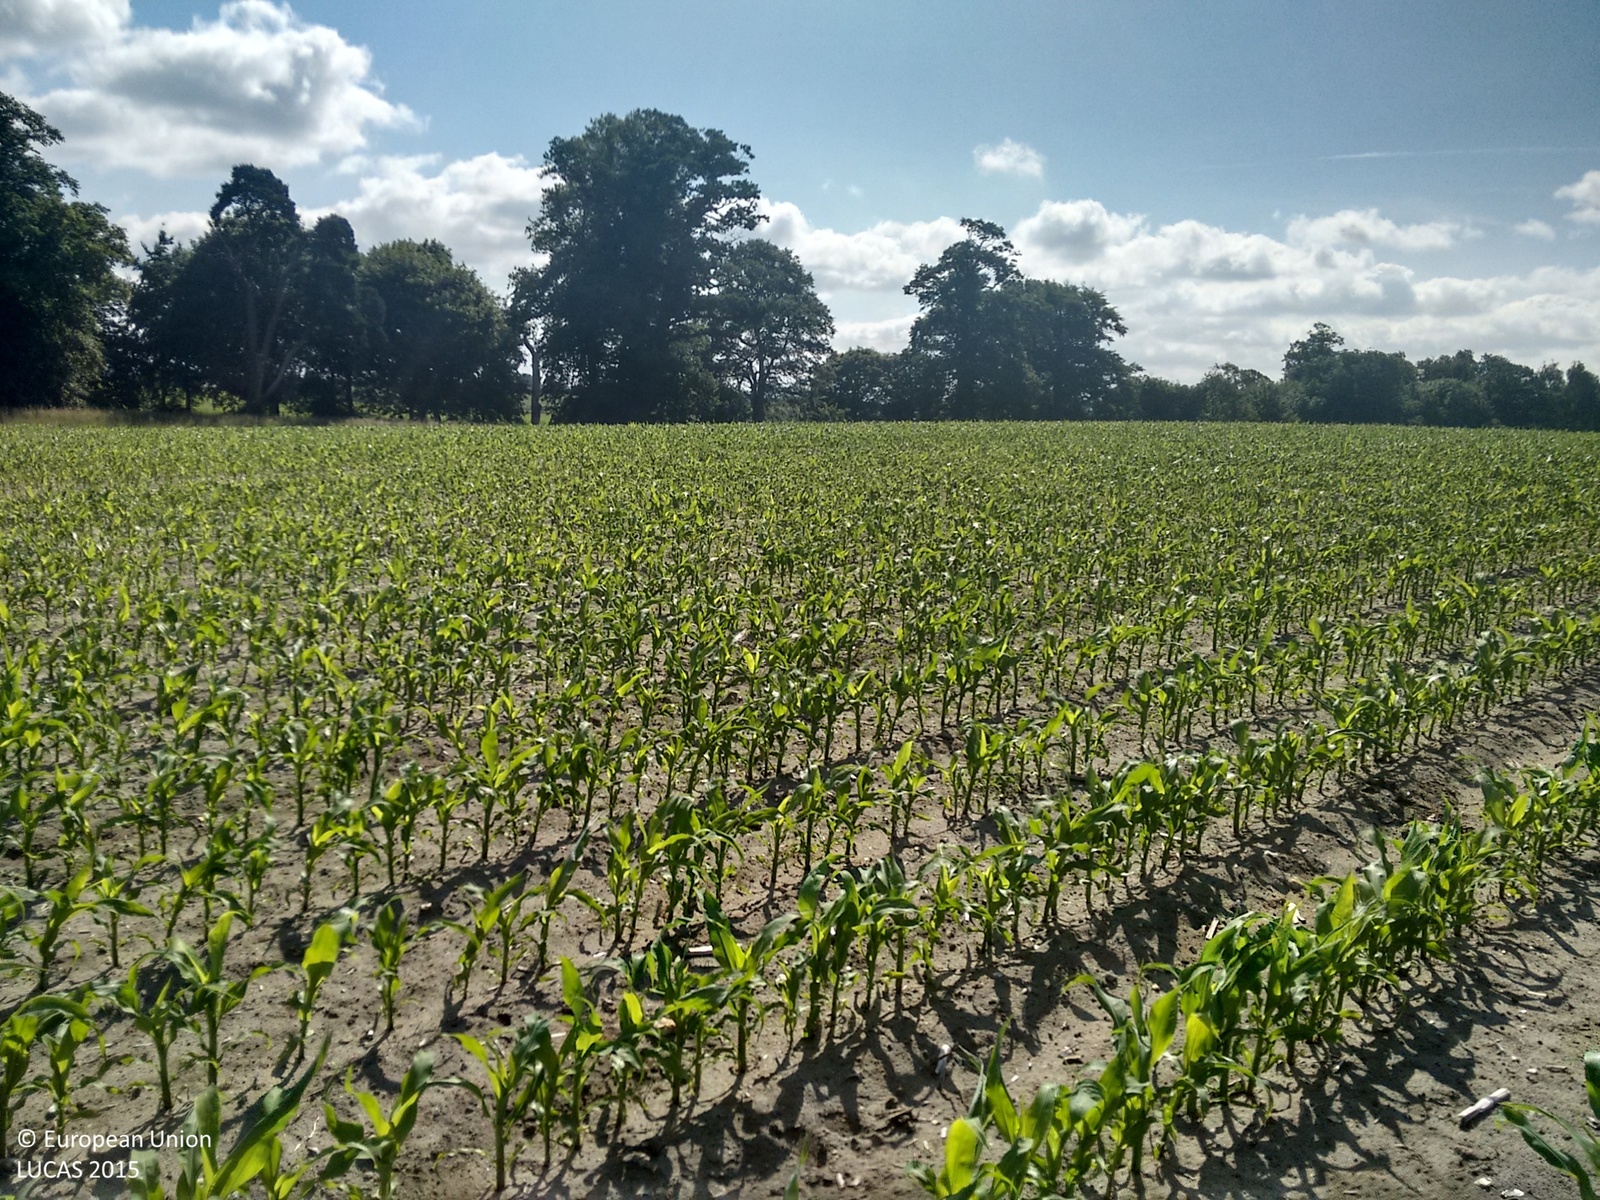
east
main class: Cropland
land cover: Maize
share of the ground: 25 - 50 %
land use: Agriculture (excluding fallow land and kitchen gardens)
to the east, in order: Maize; Spontaneously vegetated surfaces; Fences; Lines of trees; Grass margins; Paved roads, cycling and walking lanes; Grass margins; Lines of trees; Fences; Grass margins; Maize
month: June
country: GB
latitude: 51.3252
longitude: -1.8669
